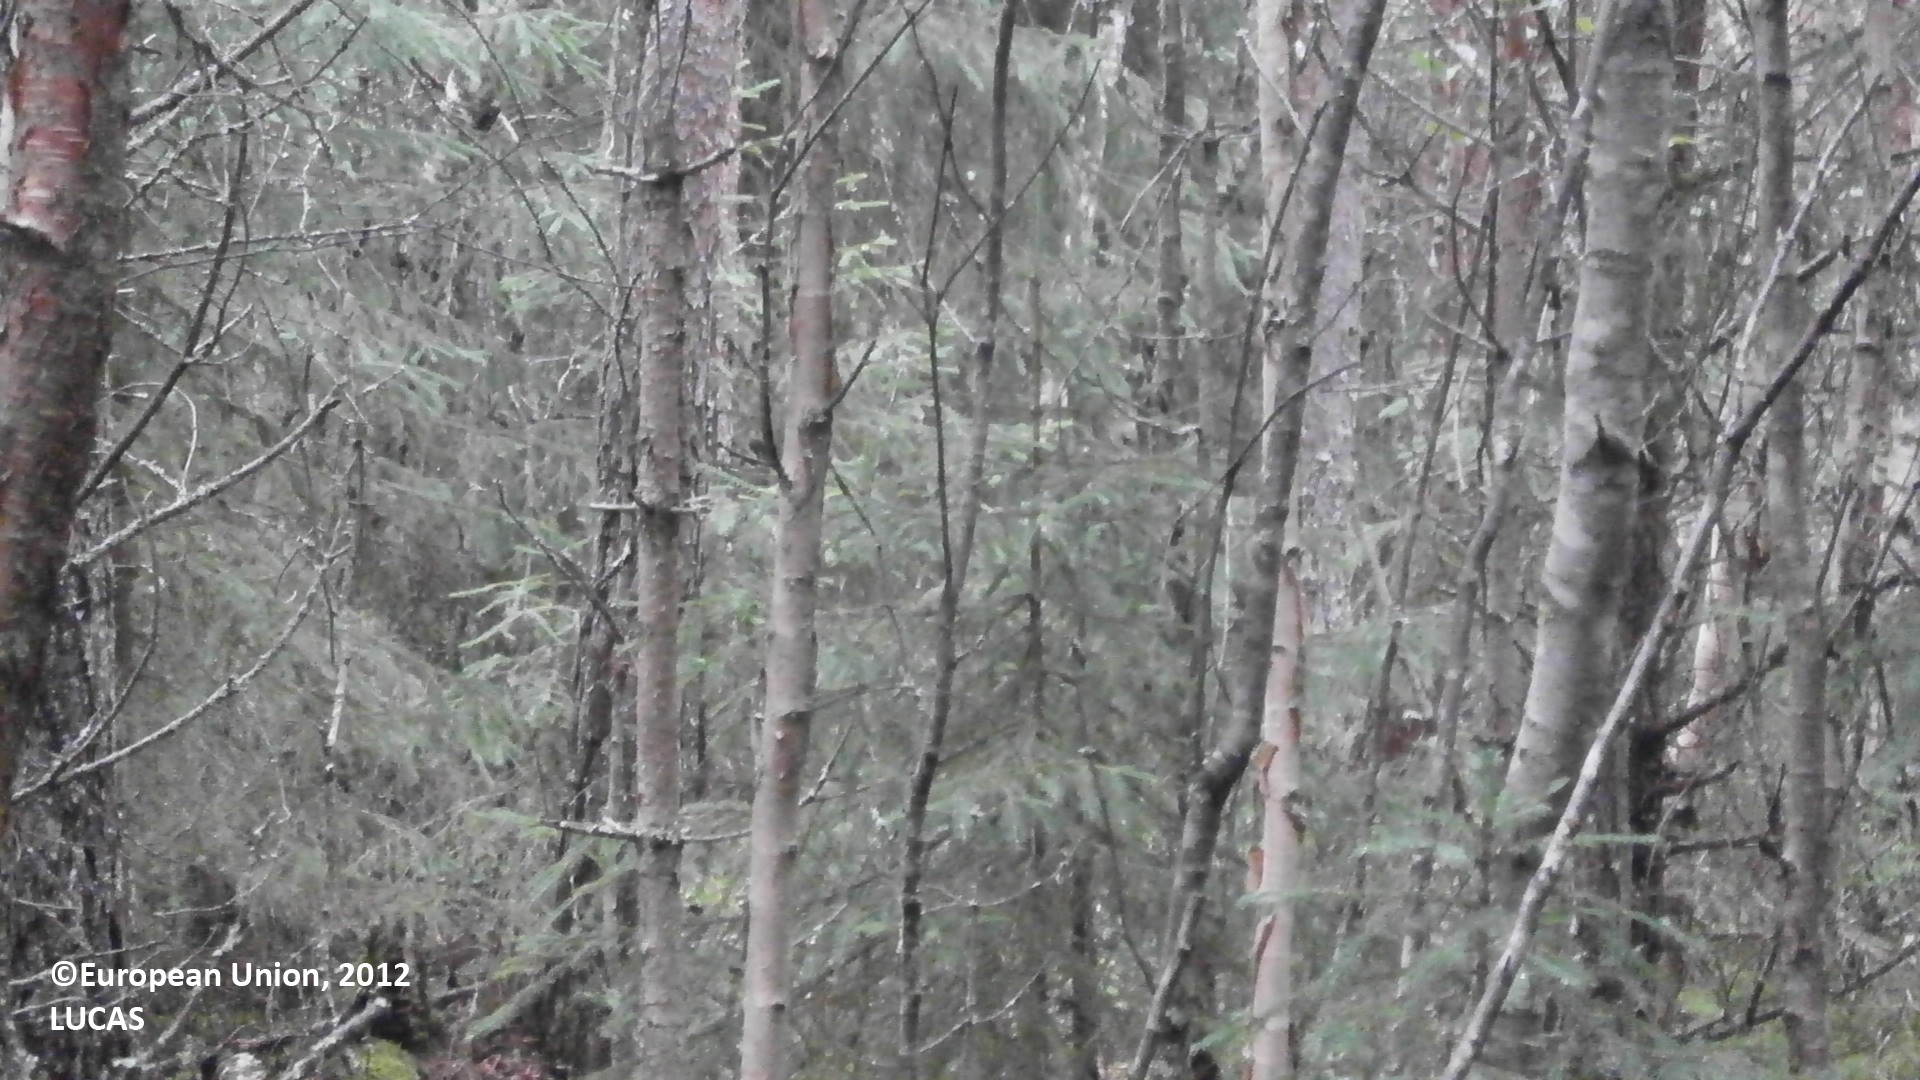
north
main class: Woodland
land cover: Pine dominated mixed woodland
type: boreal forest
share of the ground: > 75 %
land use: Forestry
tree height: > 5 m
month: July
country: FI
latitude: 64.7443
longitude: 24.6688
